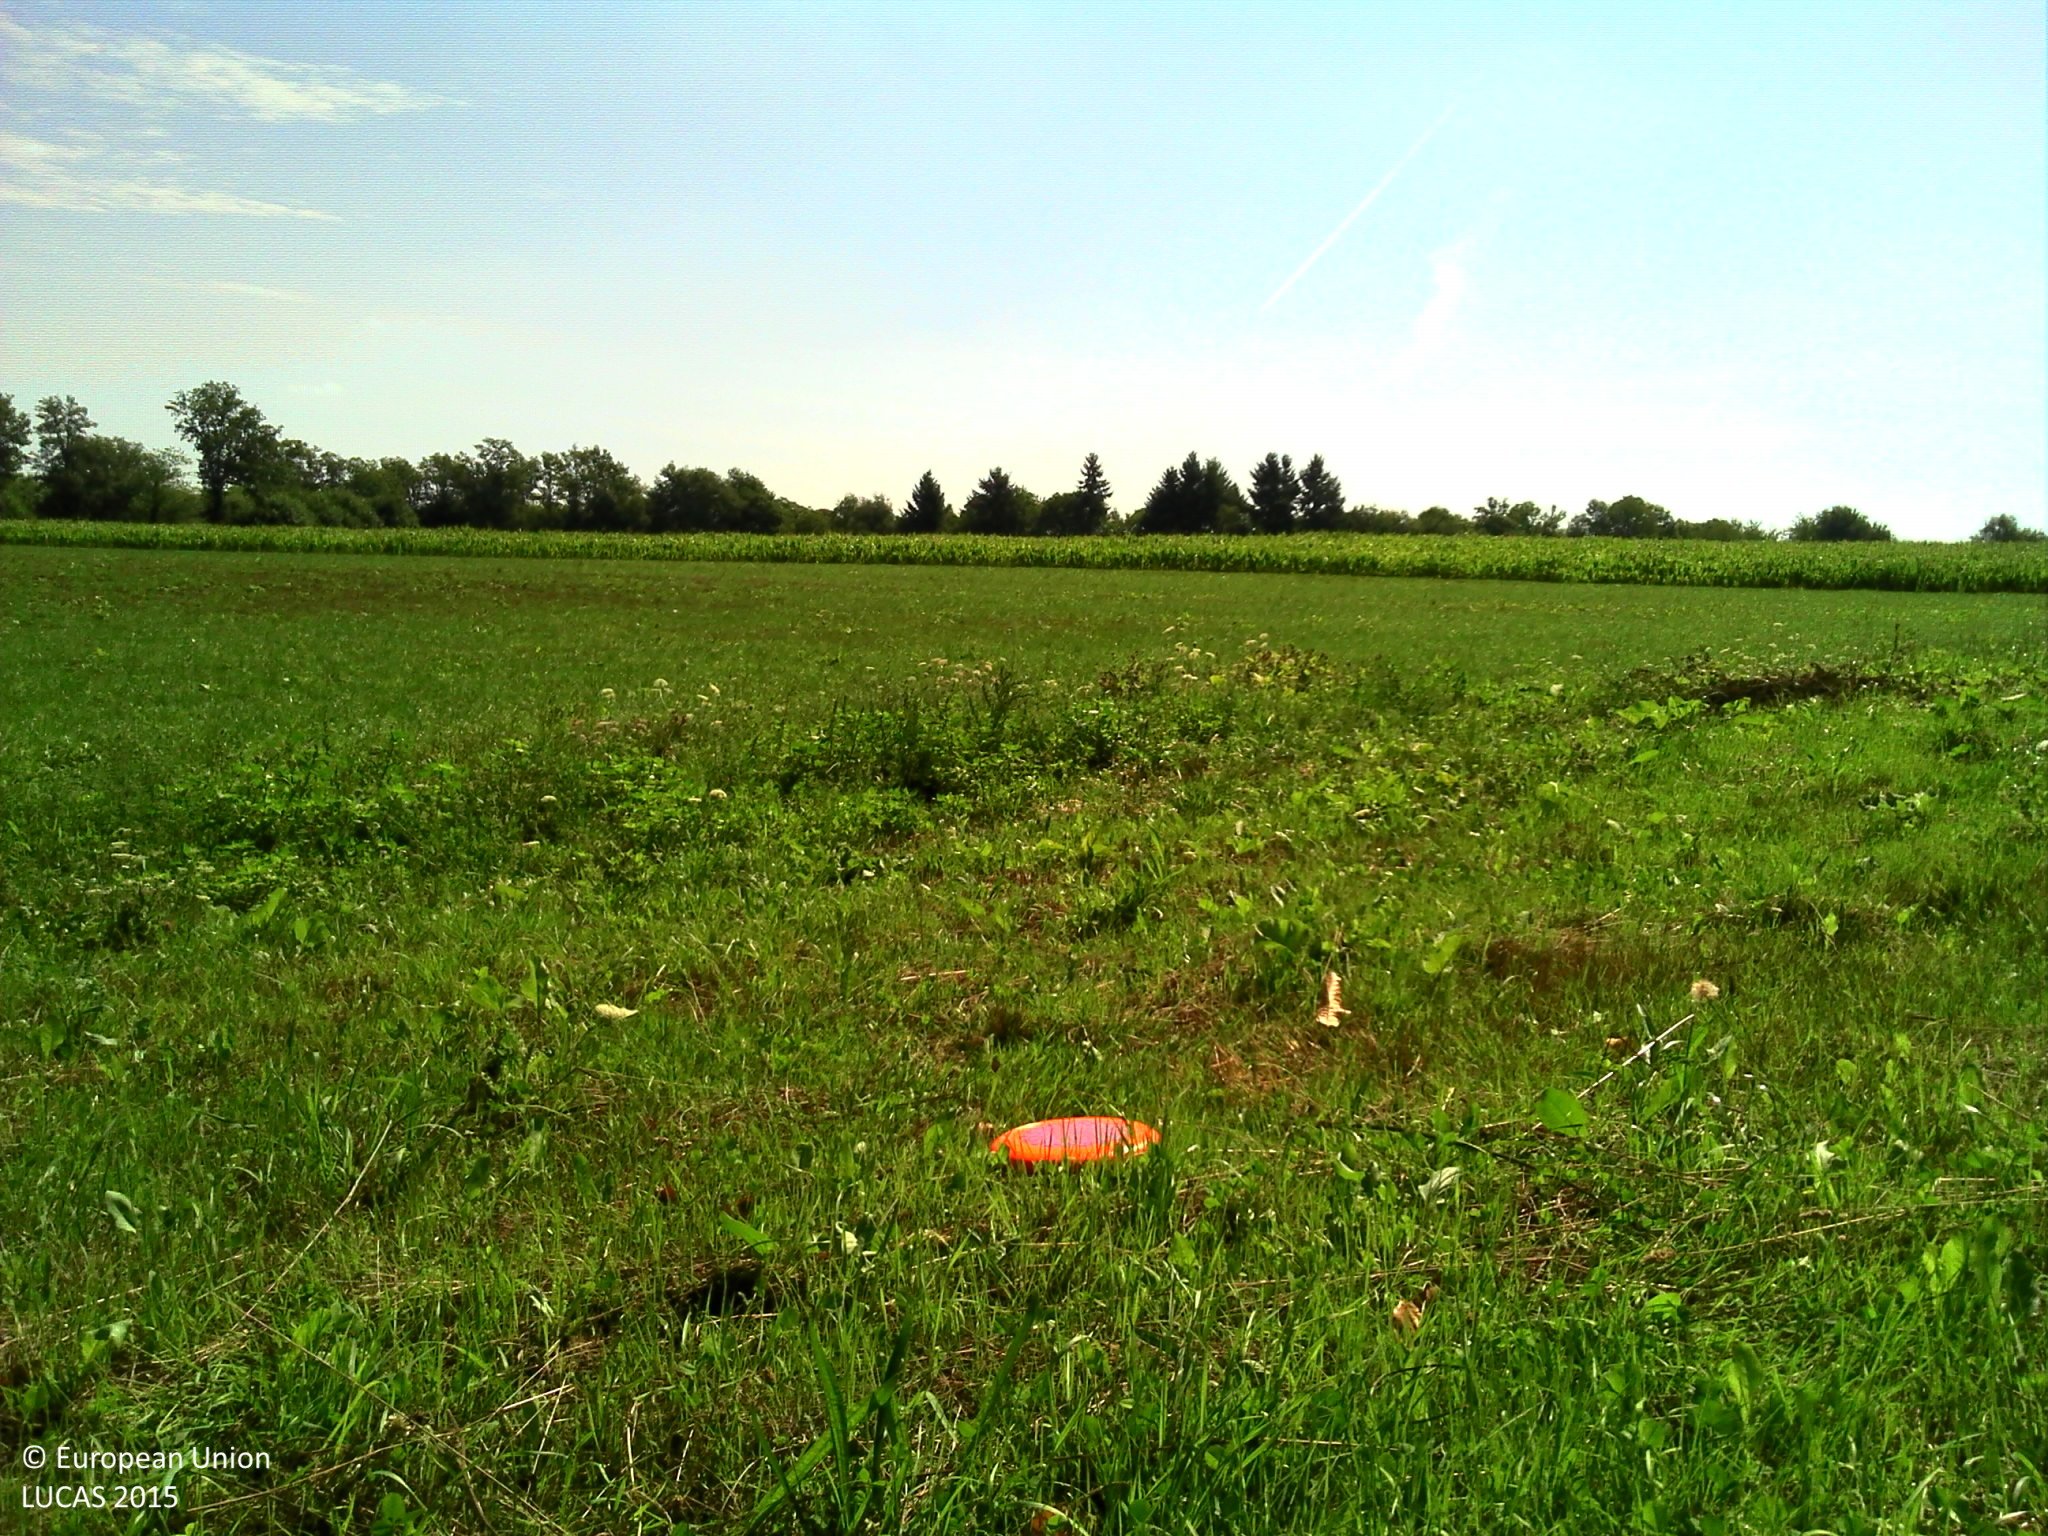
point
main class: Grassland
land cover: Spontaneously vegetated surfaces
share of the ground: > 75 %
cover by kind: herbaceous plants 95 %
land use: Agriculture (excluding fallow land and kitchen gardens)
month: August
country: FR
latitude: 45.6029
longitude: 1.3638
